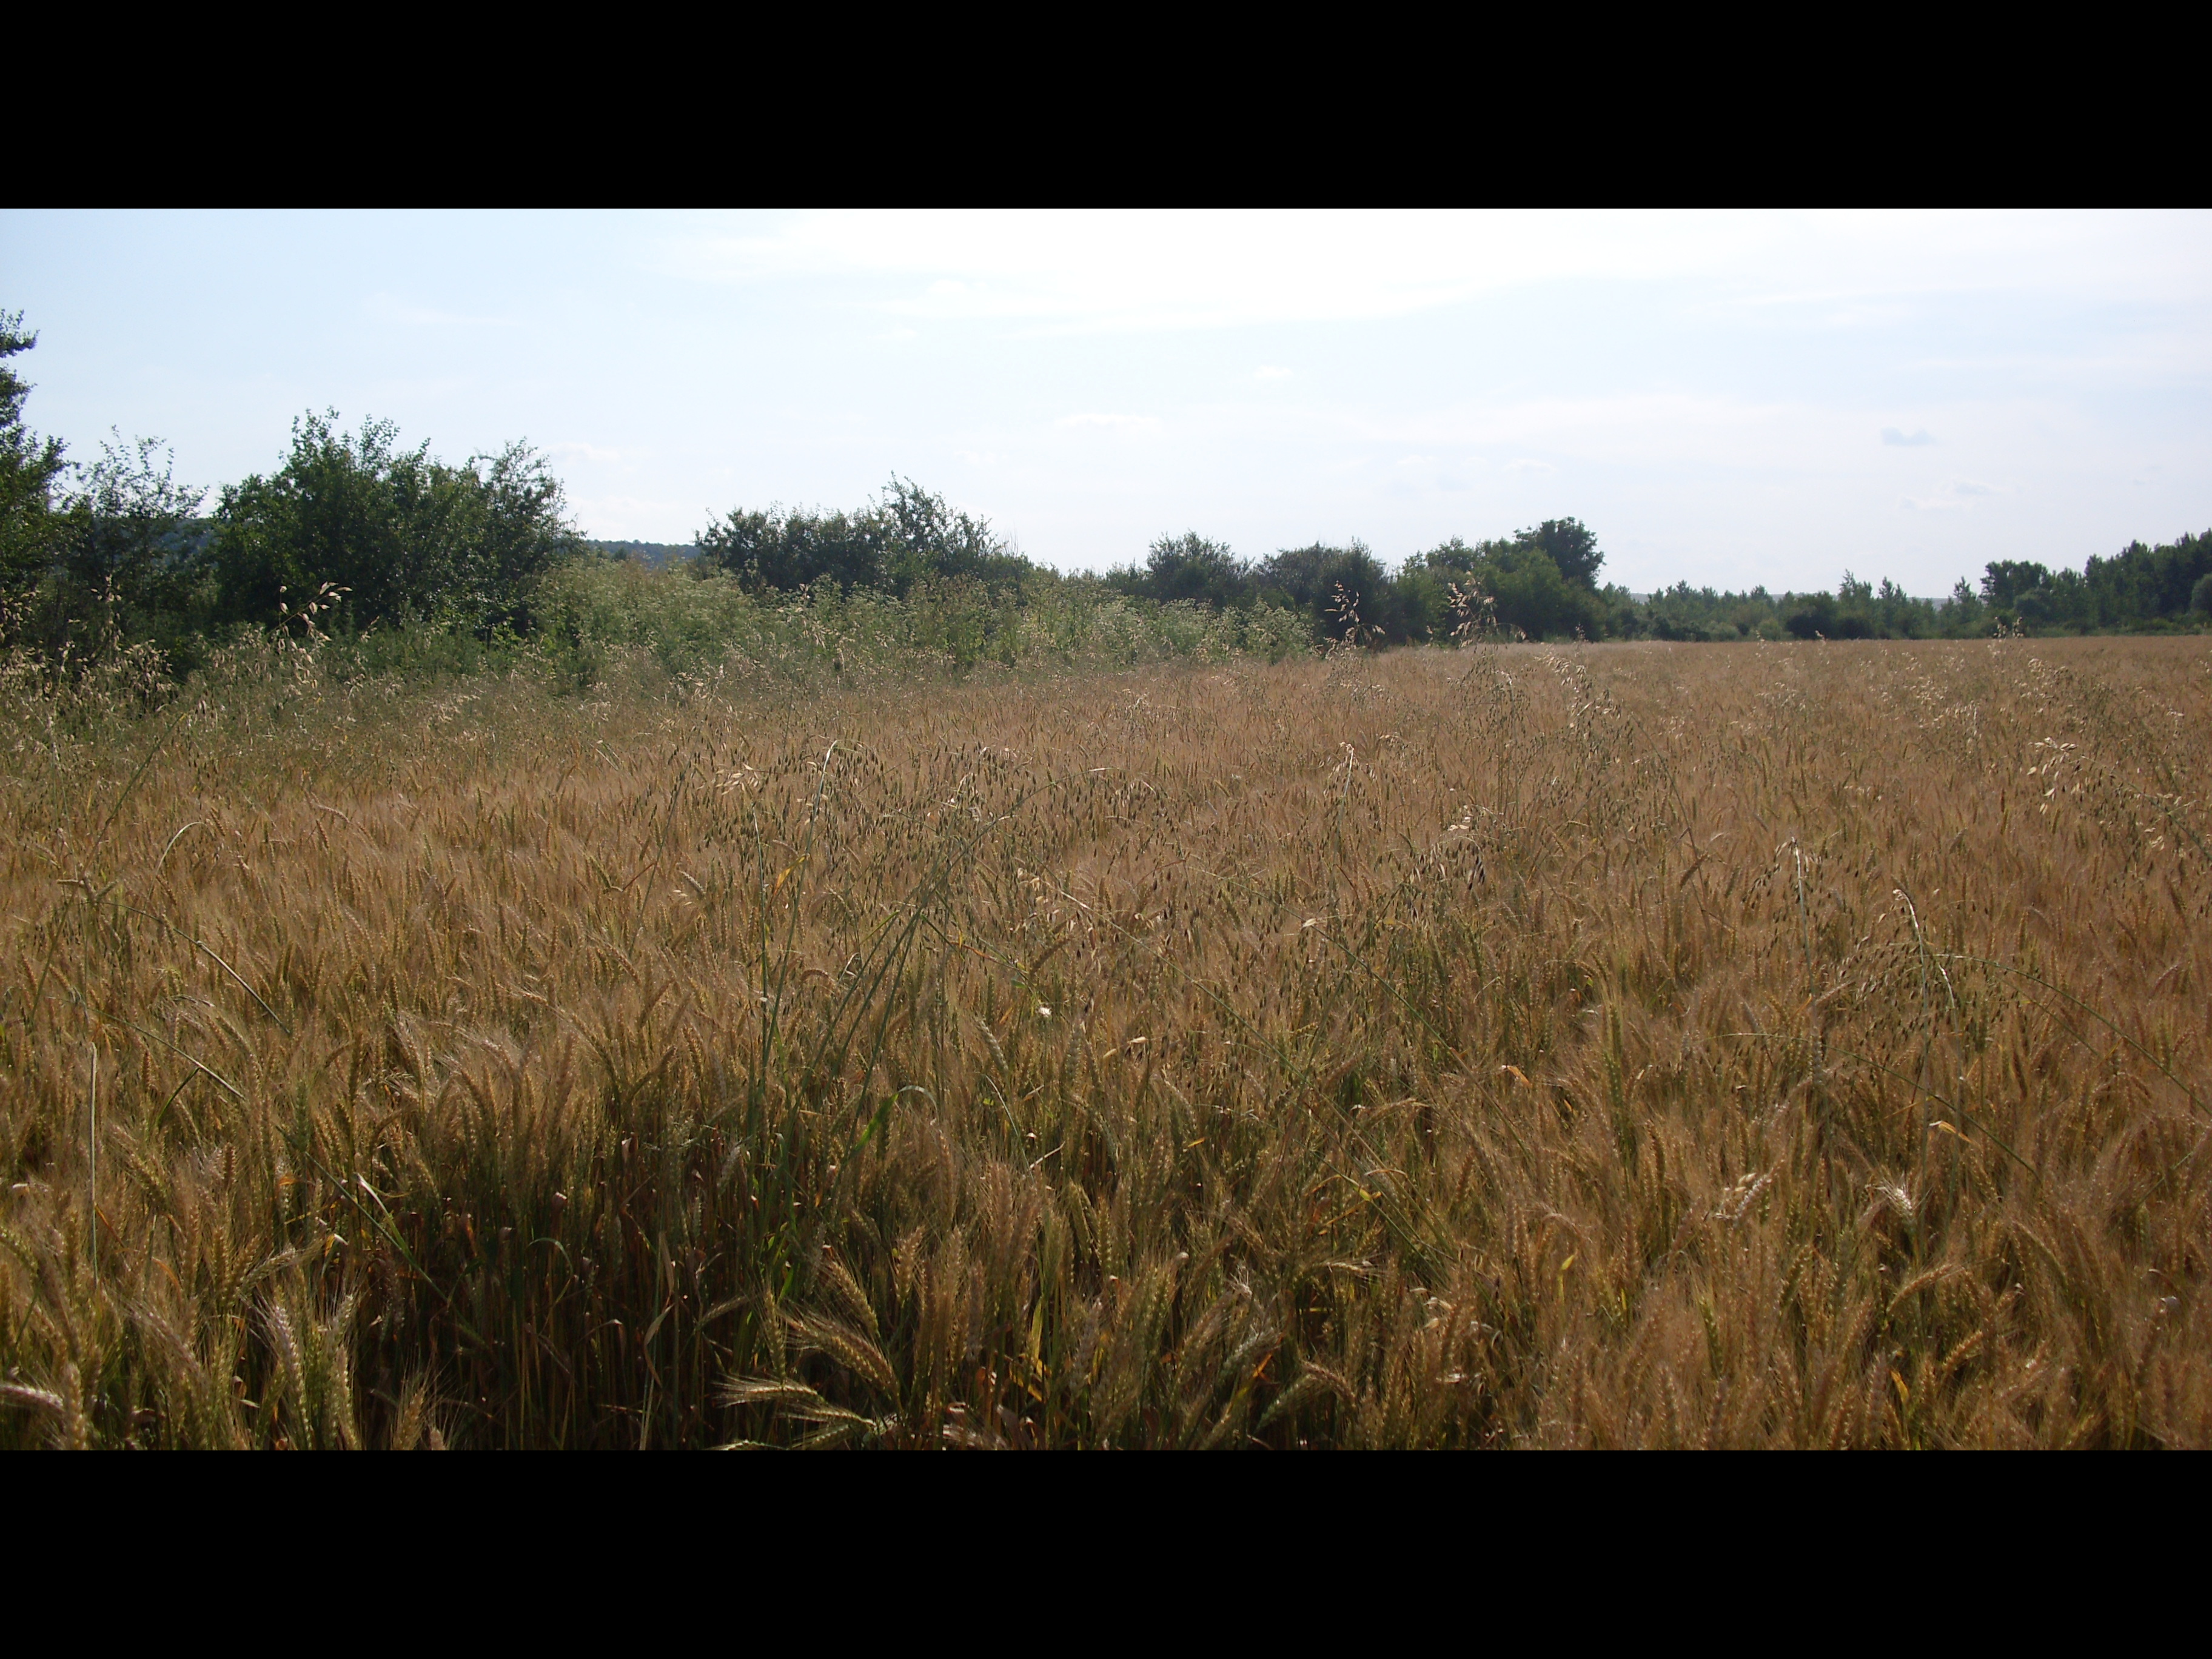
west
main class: Cropland
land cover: Common wheat
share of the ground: > 75 %
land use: Agriculture (excluding fallow land and kitchen gardens)
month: June
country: BG
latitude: 43.5292
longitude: 23.4193
